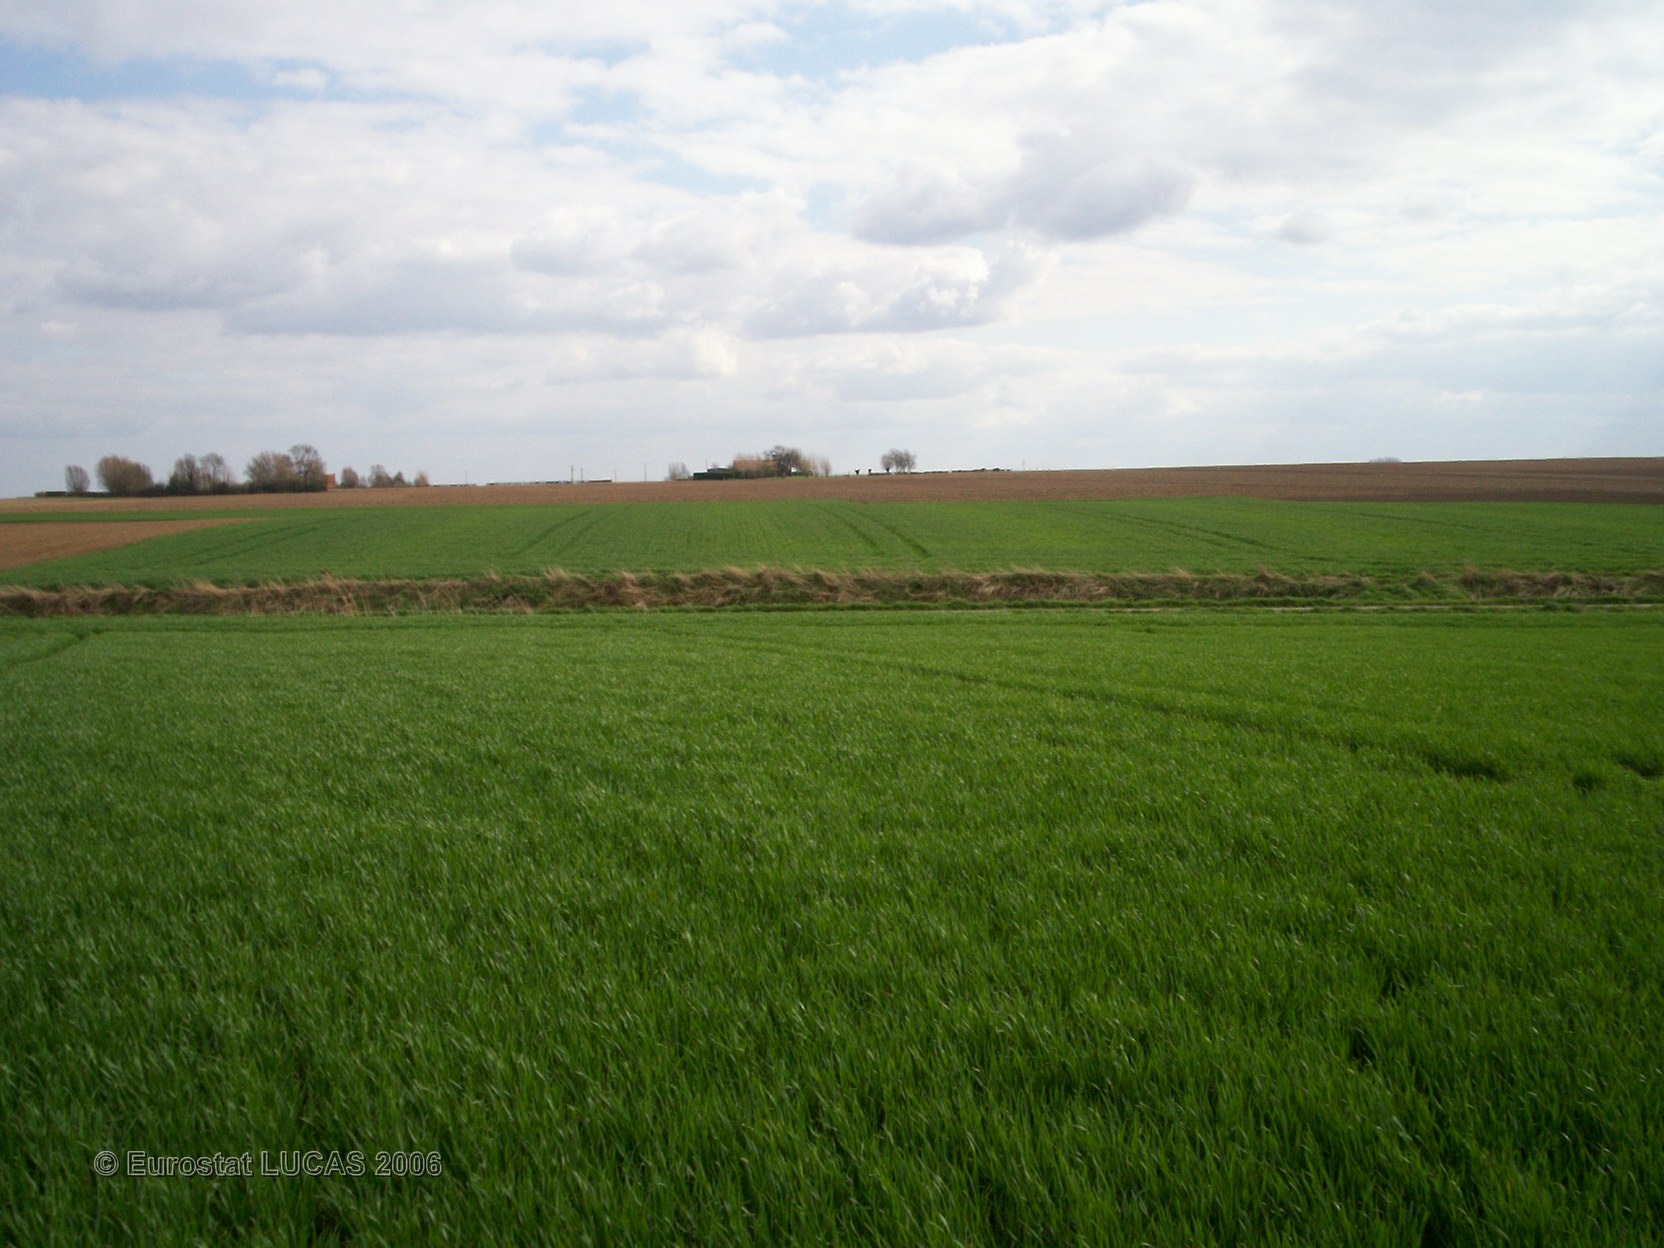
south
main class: Cropland
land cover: Common wheat
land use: Agriculture (excluding fallow land and kitchen gardens)
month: April
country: FR
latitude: 50.8846
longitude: 2.3532
